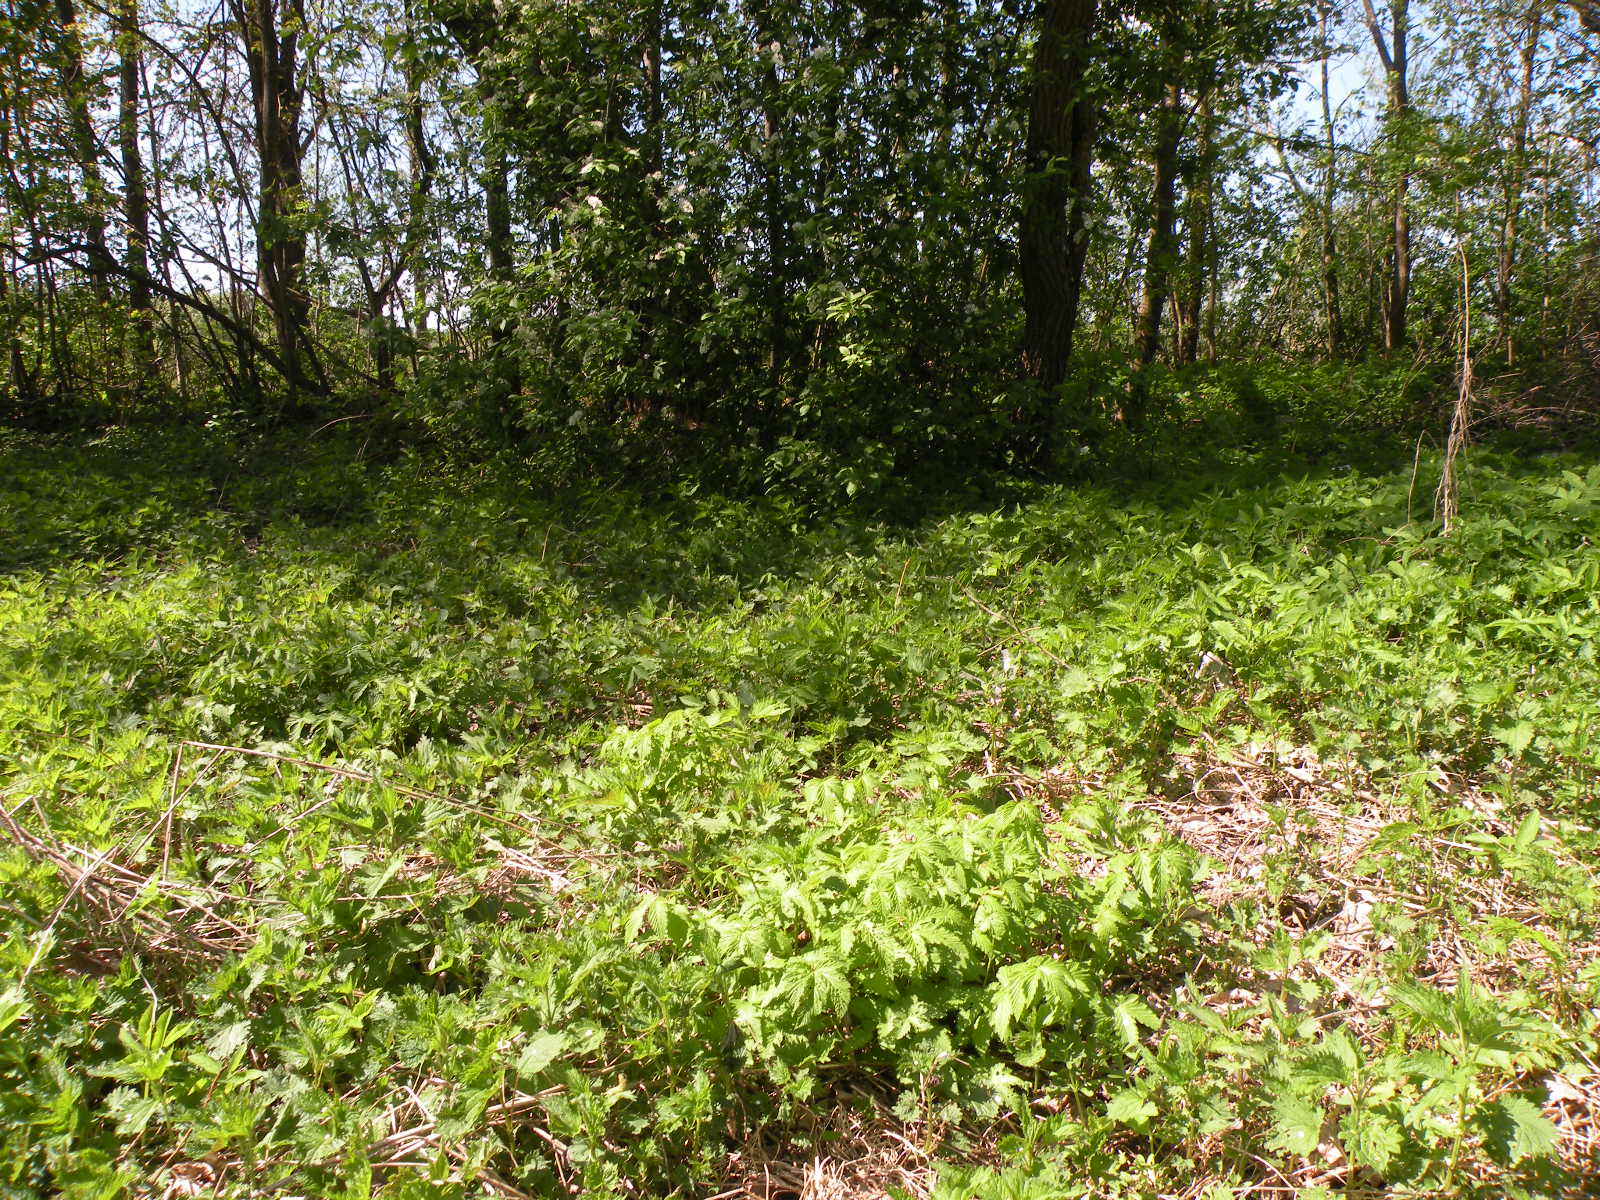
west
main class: Grassland
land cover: Spontaneously vegetated surfaces
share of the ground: > 75 %
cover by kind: herbaceous plants 90 %
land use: Semi-natural and natural areas not in use
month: May
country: LV
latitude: 56.0567
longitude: 26.2821
